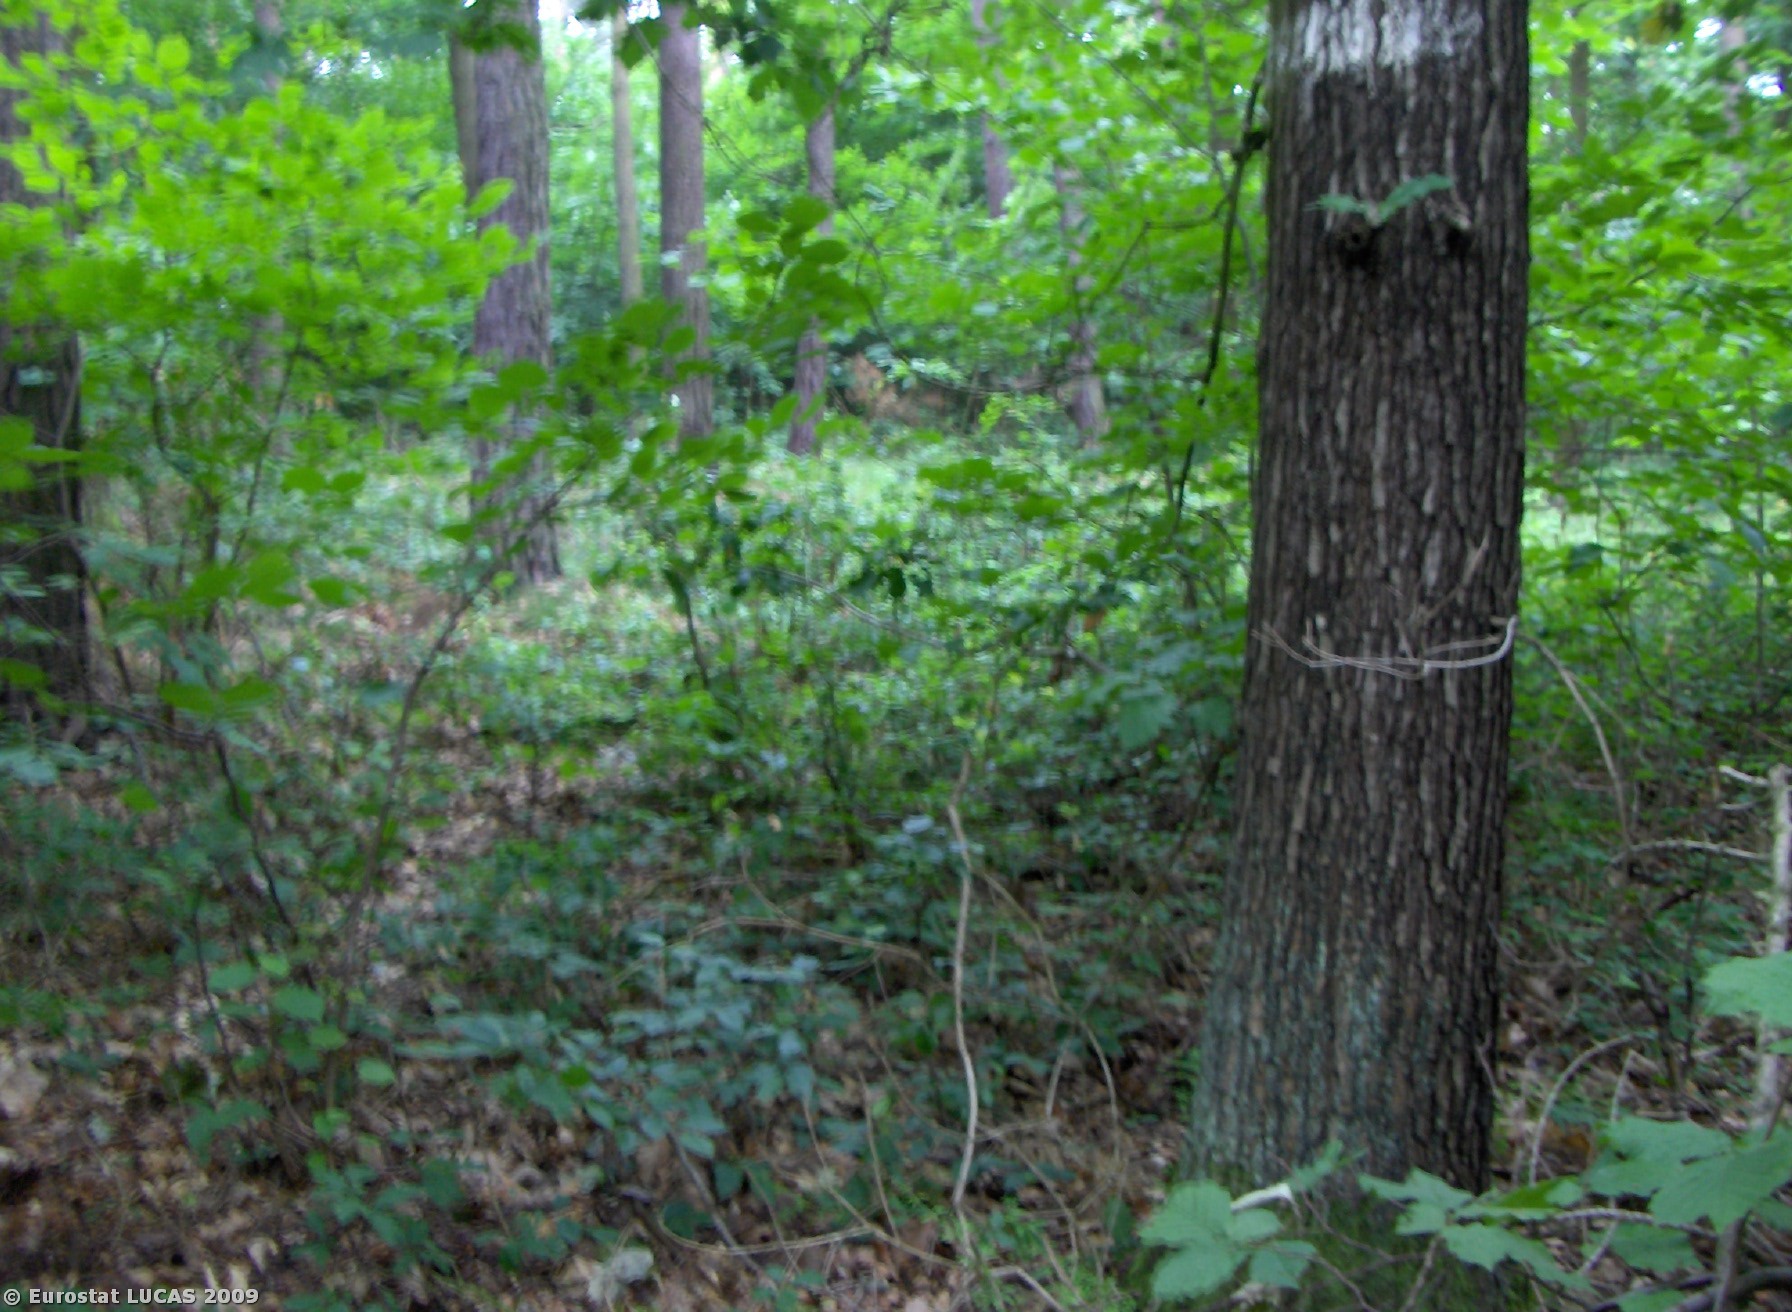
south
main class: Woodland
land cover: Mixed woodland
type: hemiboreal forest and nemoral coniferous forest and mixed broadleaved-coniferous forest
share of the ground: > 75 %
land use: Nature reserves
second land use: Forestry
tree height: > 5 m
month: June
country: CZ
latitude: 49.7223
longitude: 14.3707
